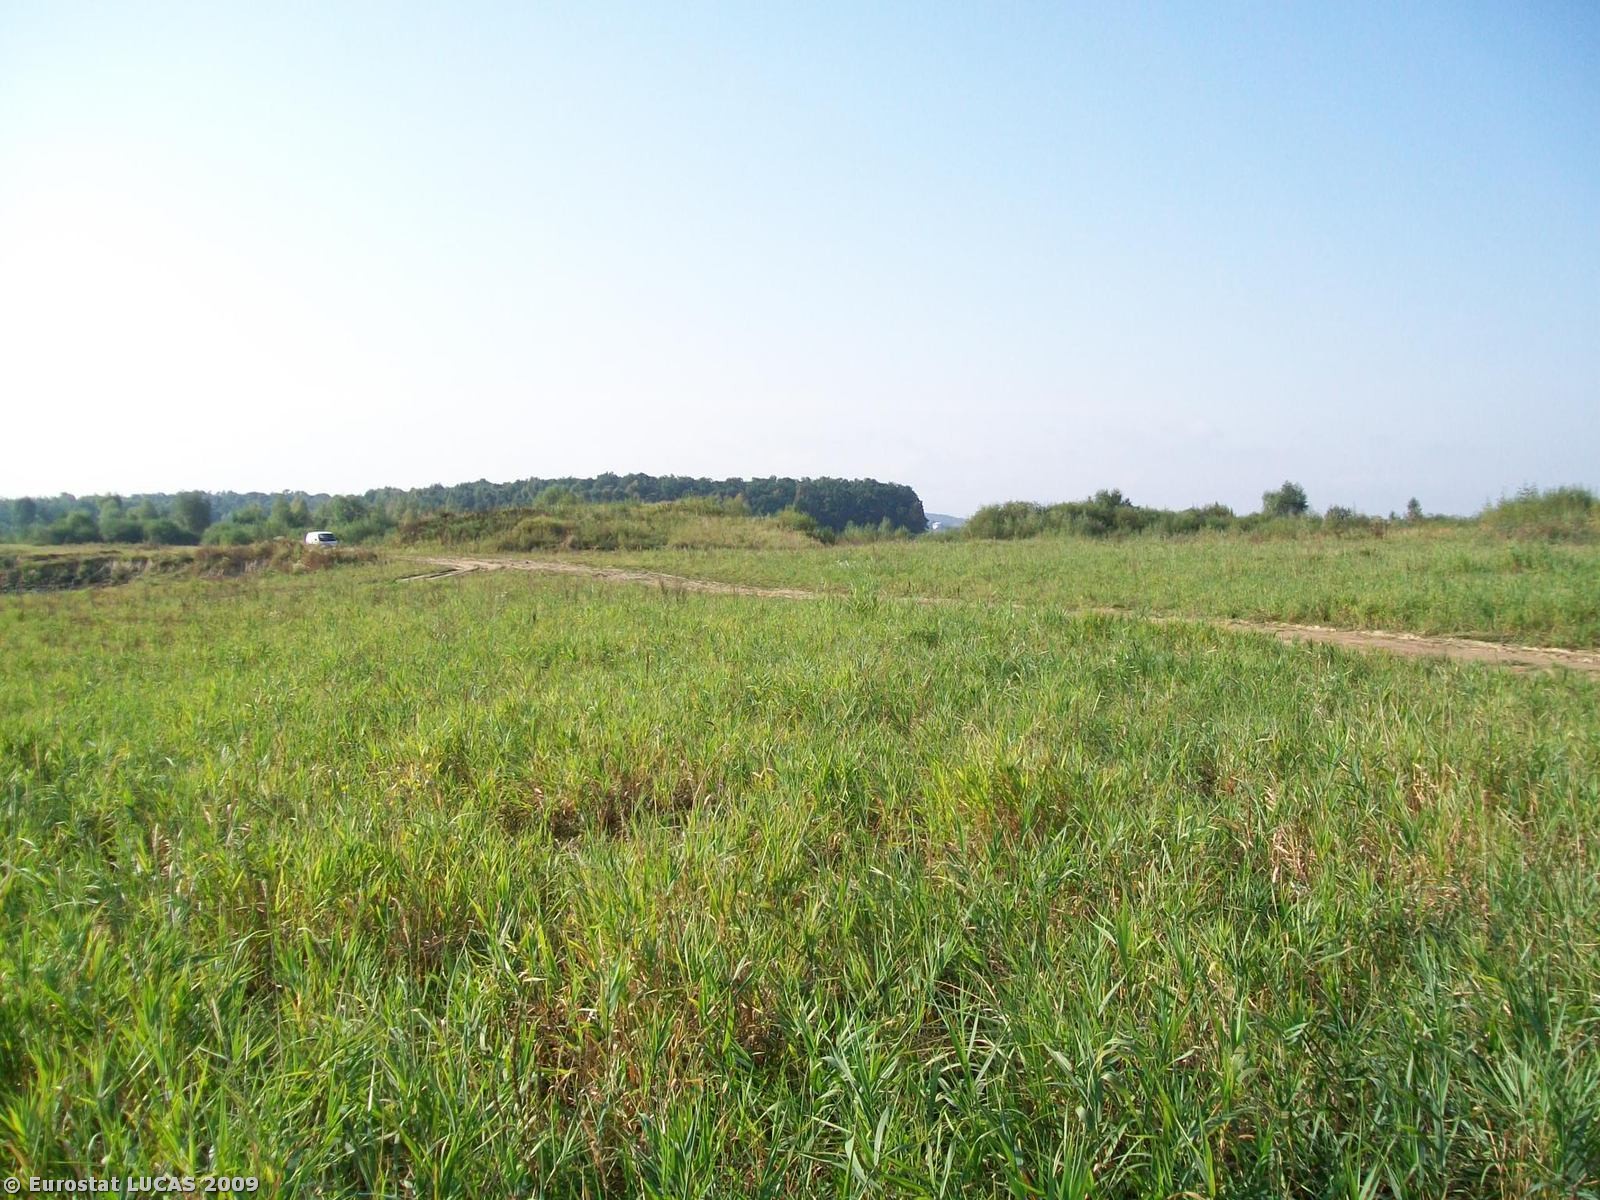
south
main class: Grassland
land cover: Grassland without tree/shrub cover
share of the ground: > 75 %
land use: Unused
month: September
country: PL
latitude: 50.4418
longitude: 17.2347
